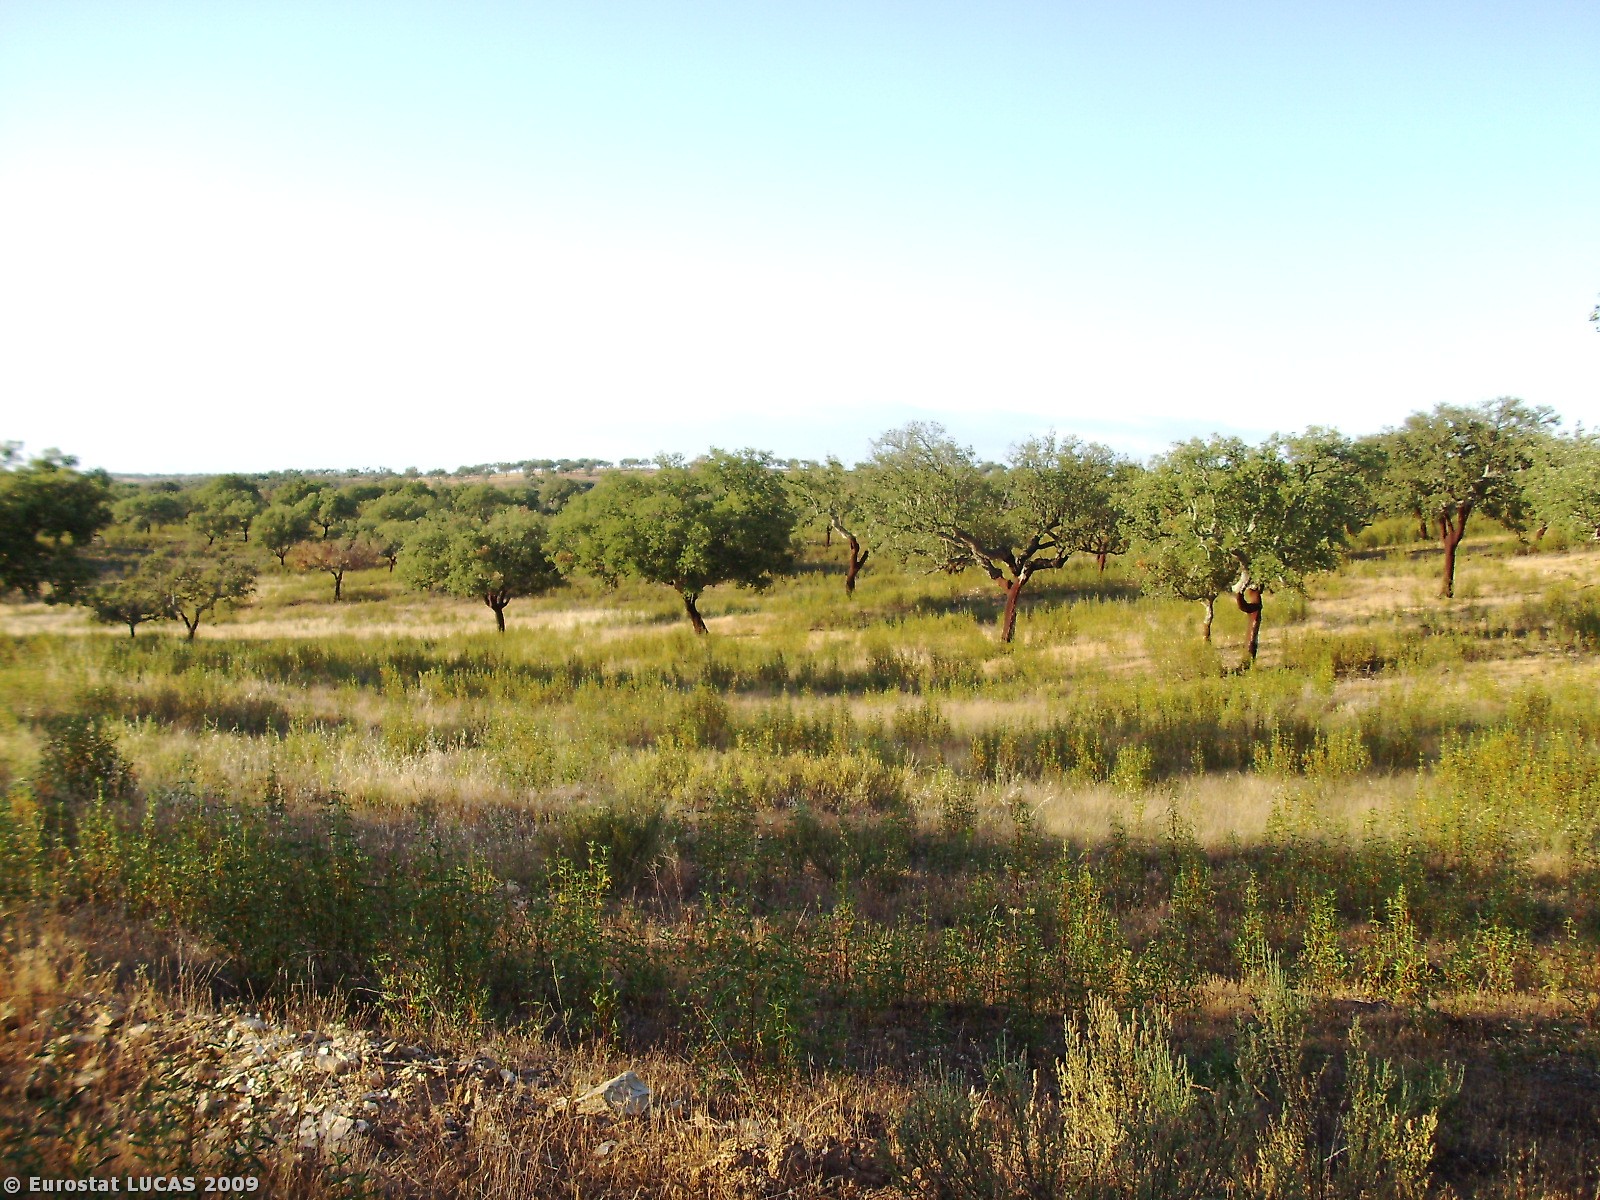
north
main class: Woodland
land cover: Broadleaved woodland
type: broadleaved evergreen forest
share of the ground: 10 - 25 %
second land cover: Spontaneously vegetated surfaces
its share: 50 - 75 %
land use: Forestry
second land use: Fallow land
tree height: > 5 m
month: April
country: PT
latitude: 39.5415
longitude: -7.5371
